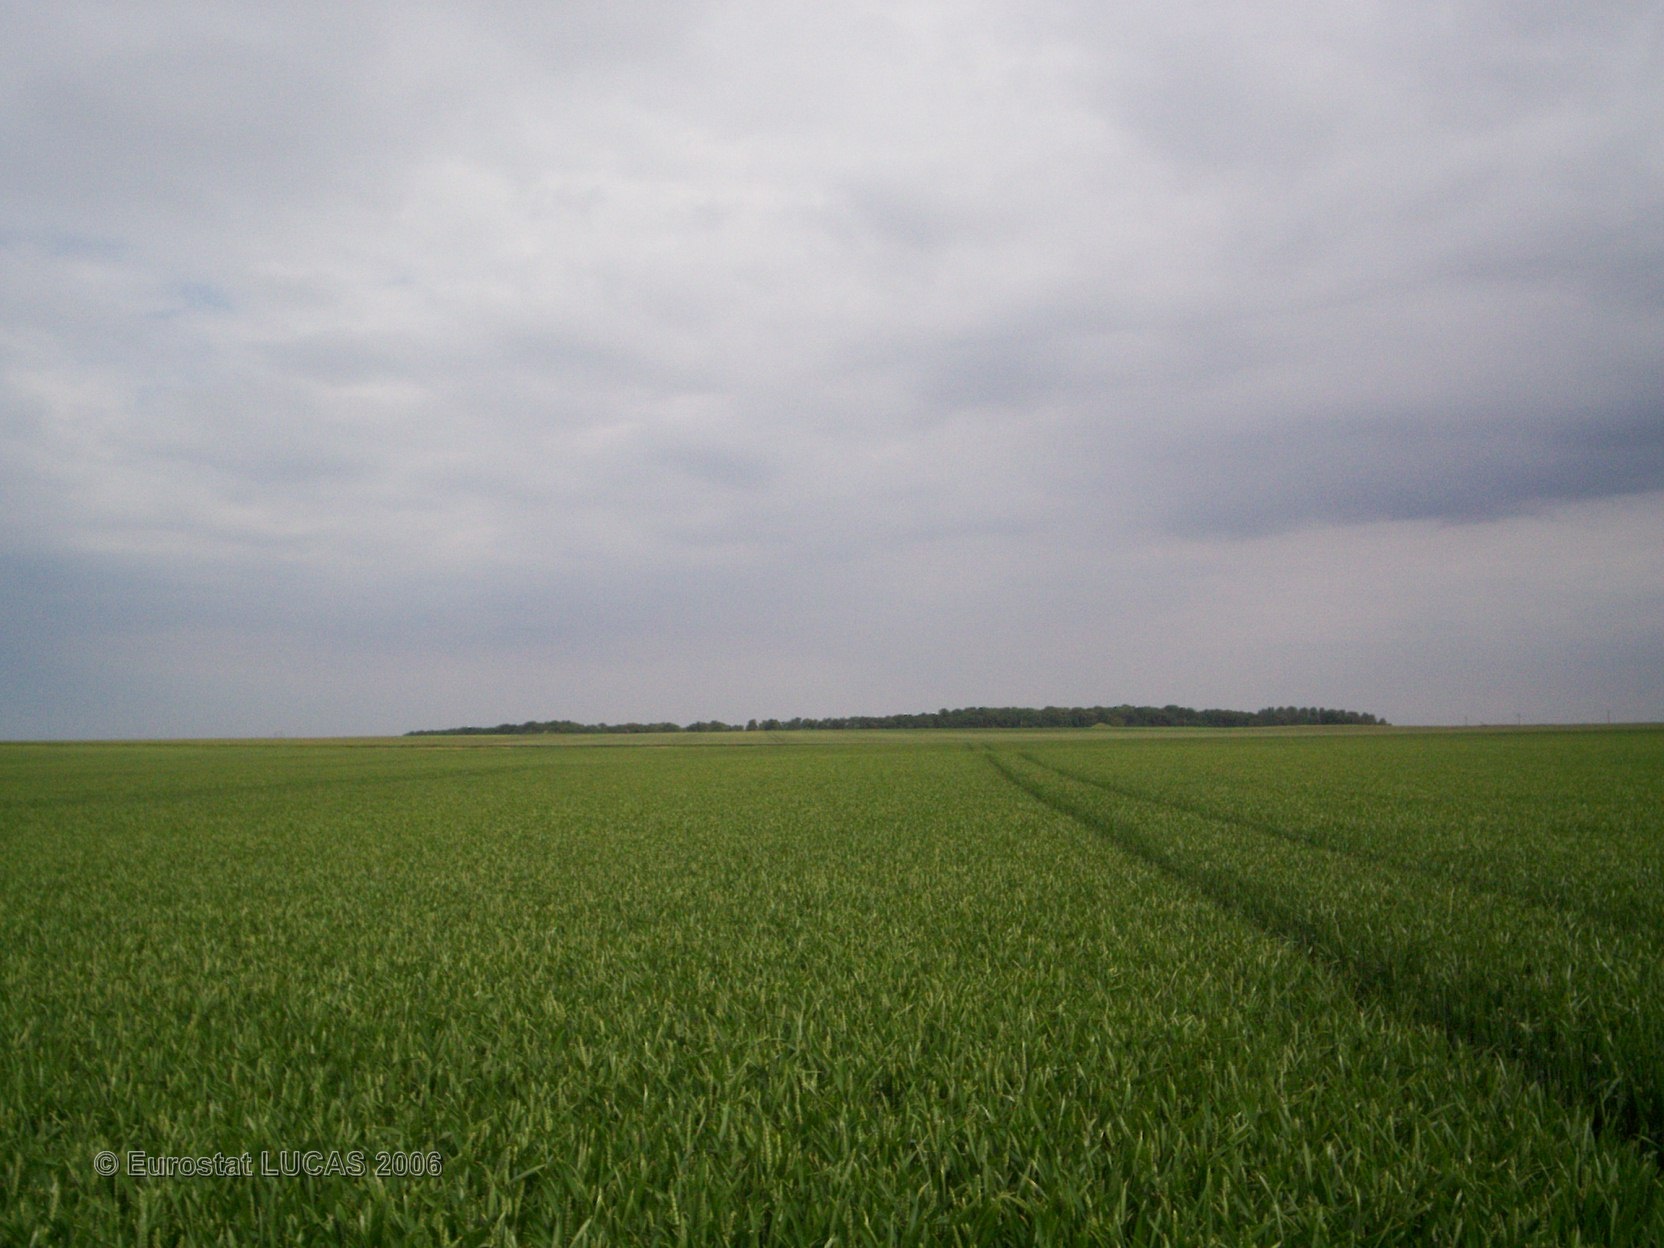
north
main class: Cropland
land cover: Common wheat
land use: Agriculture (excluding fallow land and kitchen gardens)
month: June
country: FR
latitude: 49.4476
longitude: 2.7479
